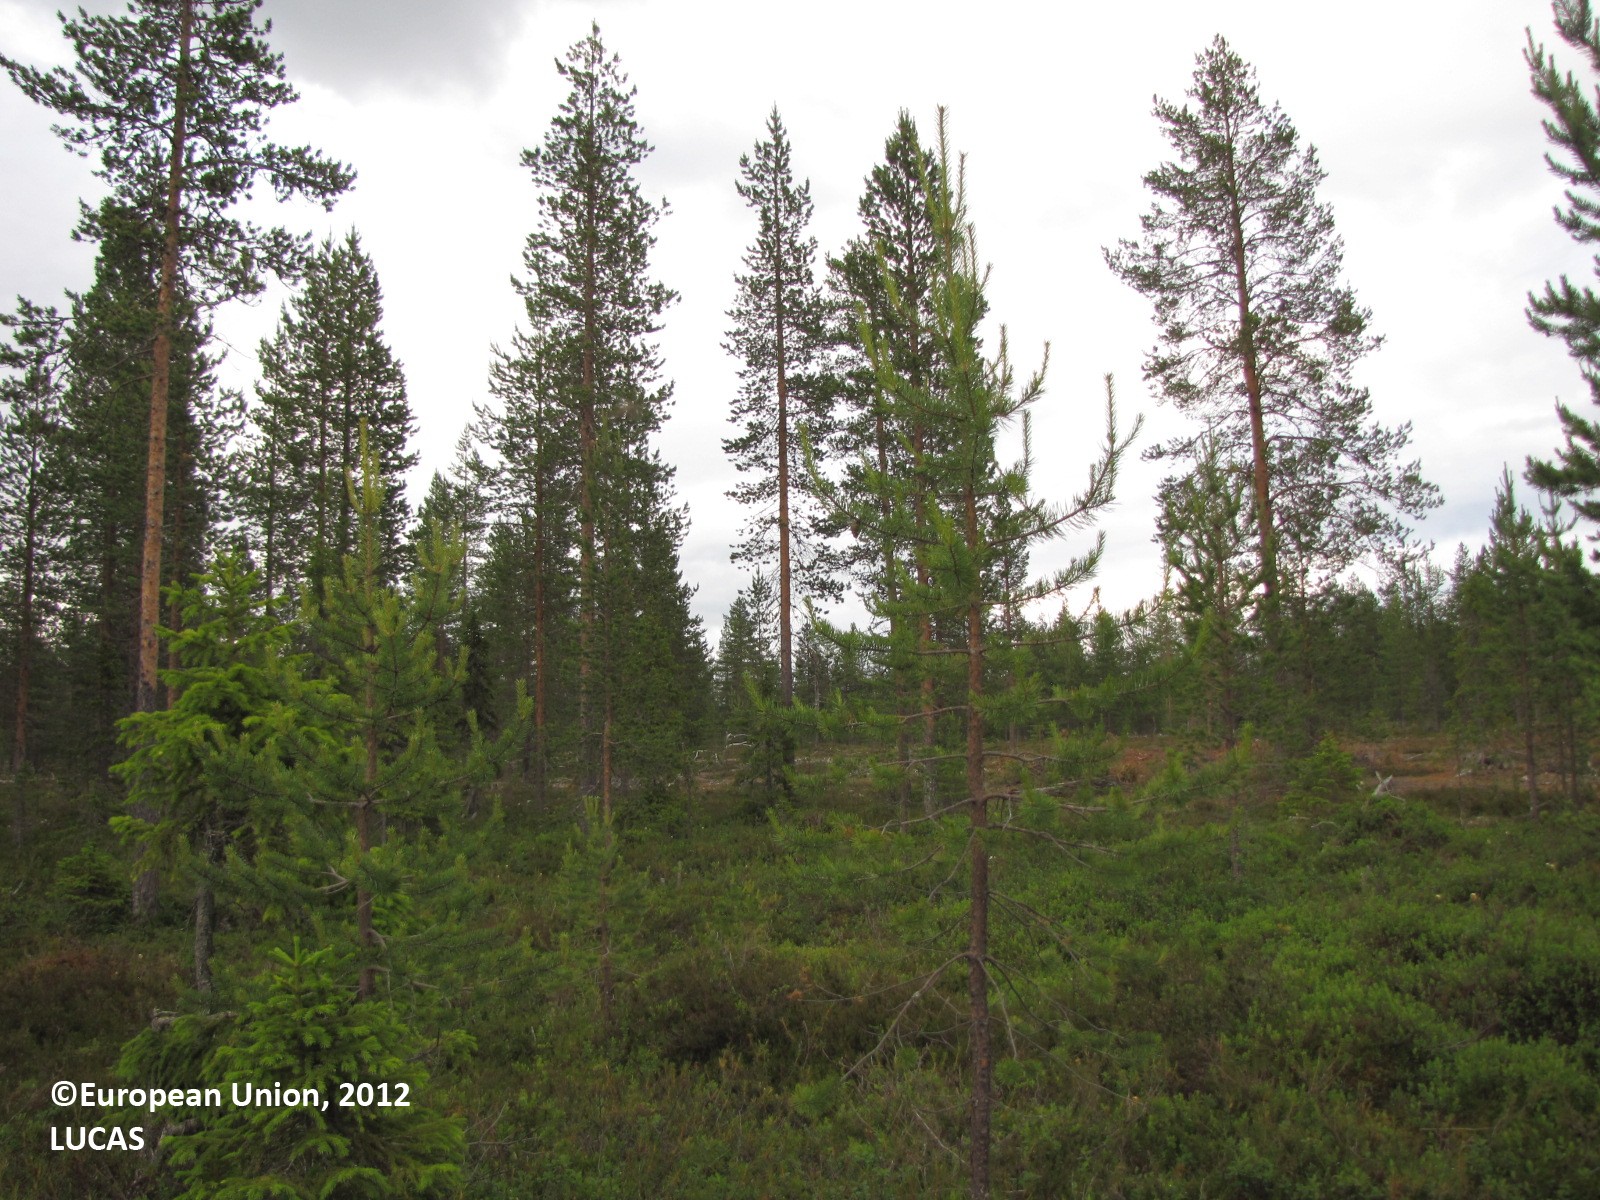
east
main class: Woodland
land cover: Pine dominated coniferous woodland
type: boreal forest
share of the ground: 10 - 25 %
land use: Forestry
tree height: > 5 m
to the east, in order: Pine dominated coniferous woodland
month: July
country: FI
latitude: 66.5481
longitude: 25.1656
